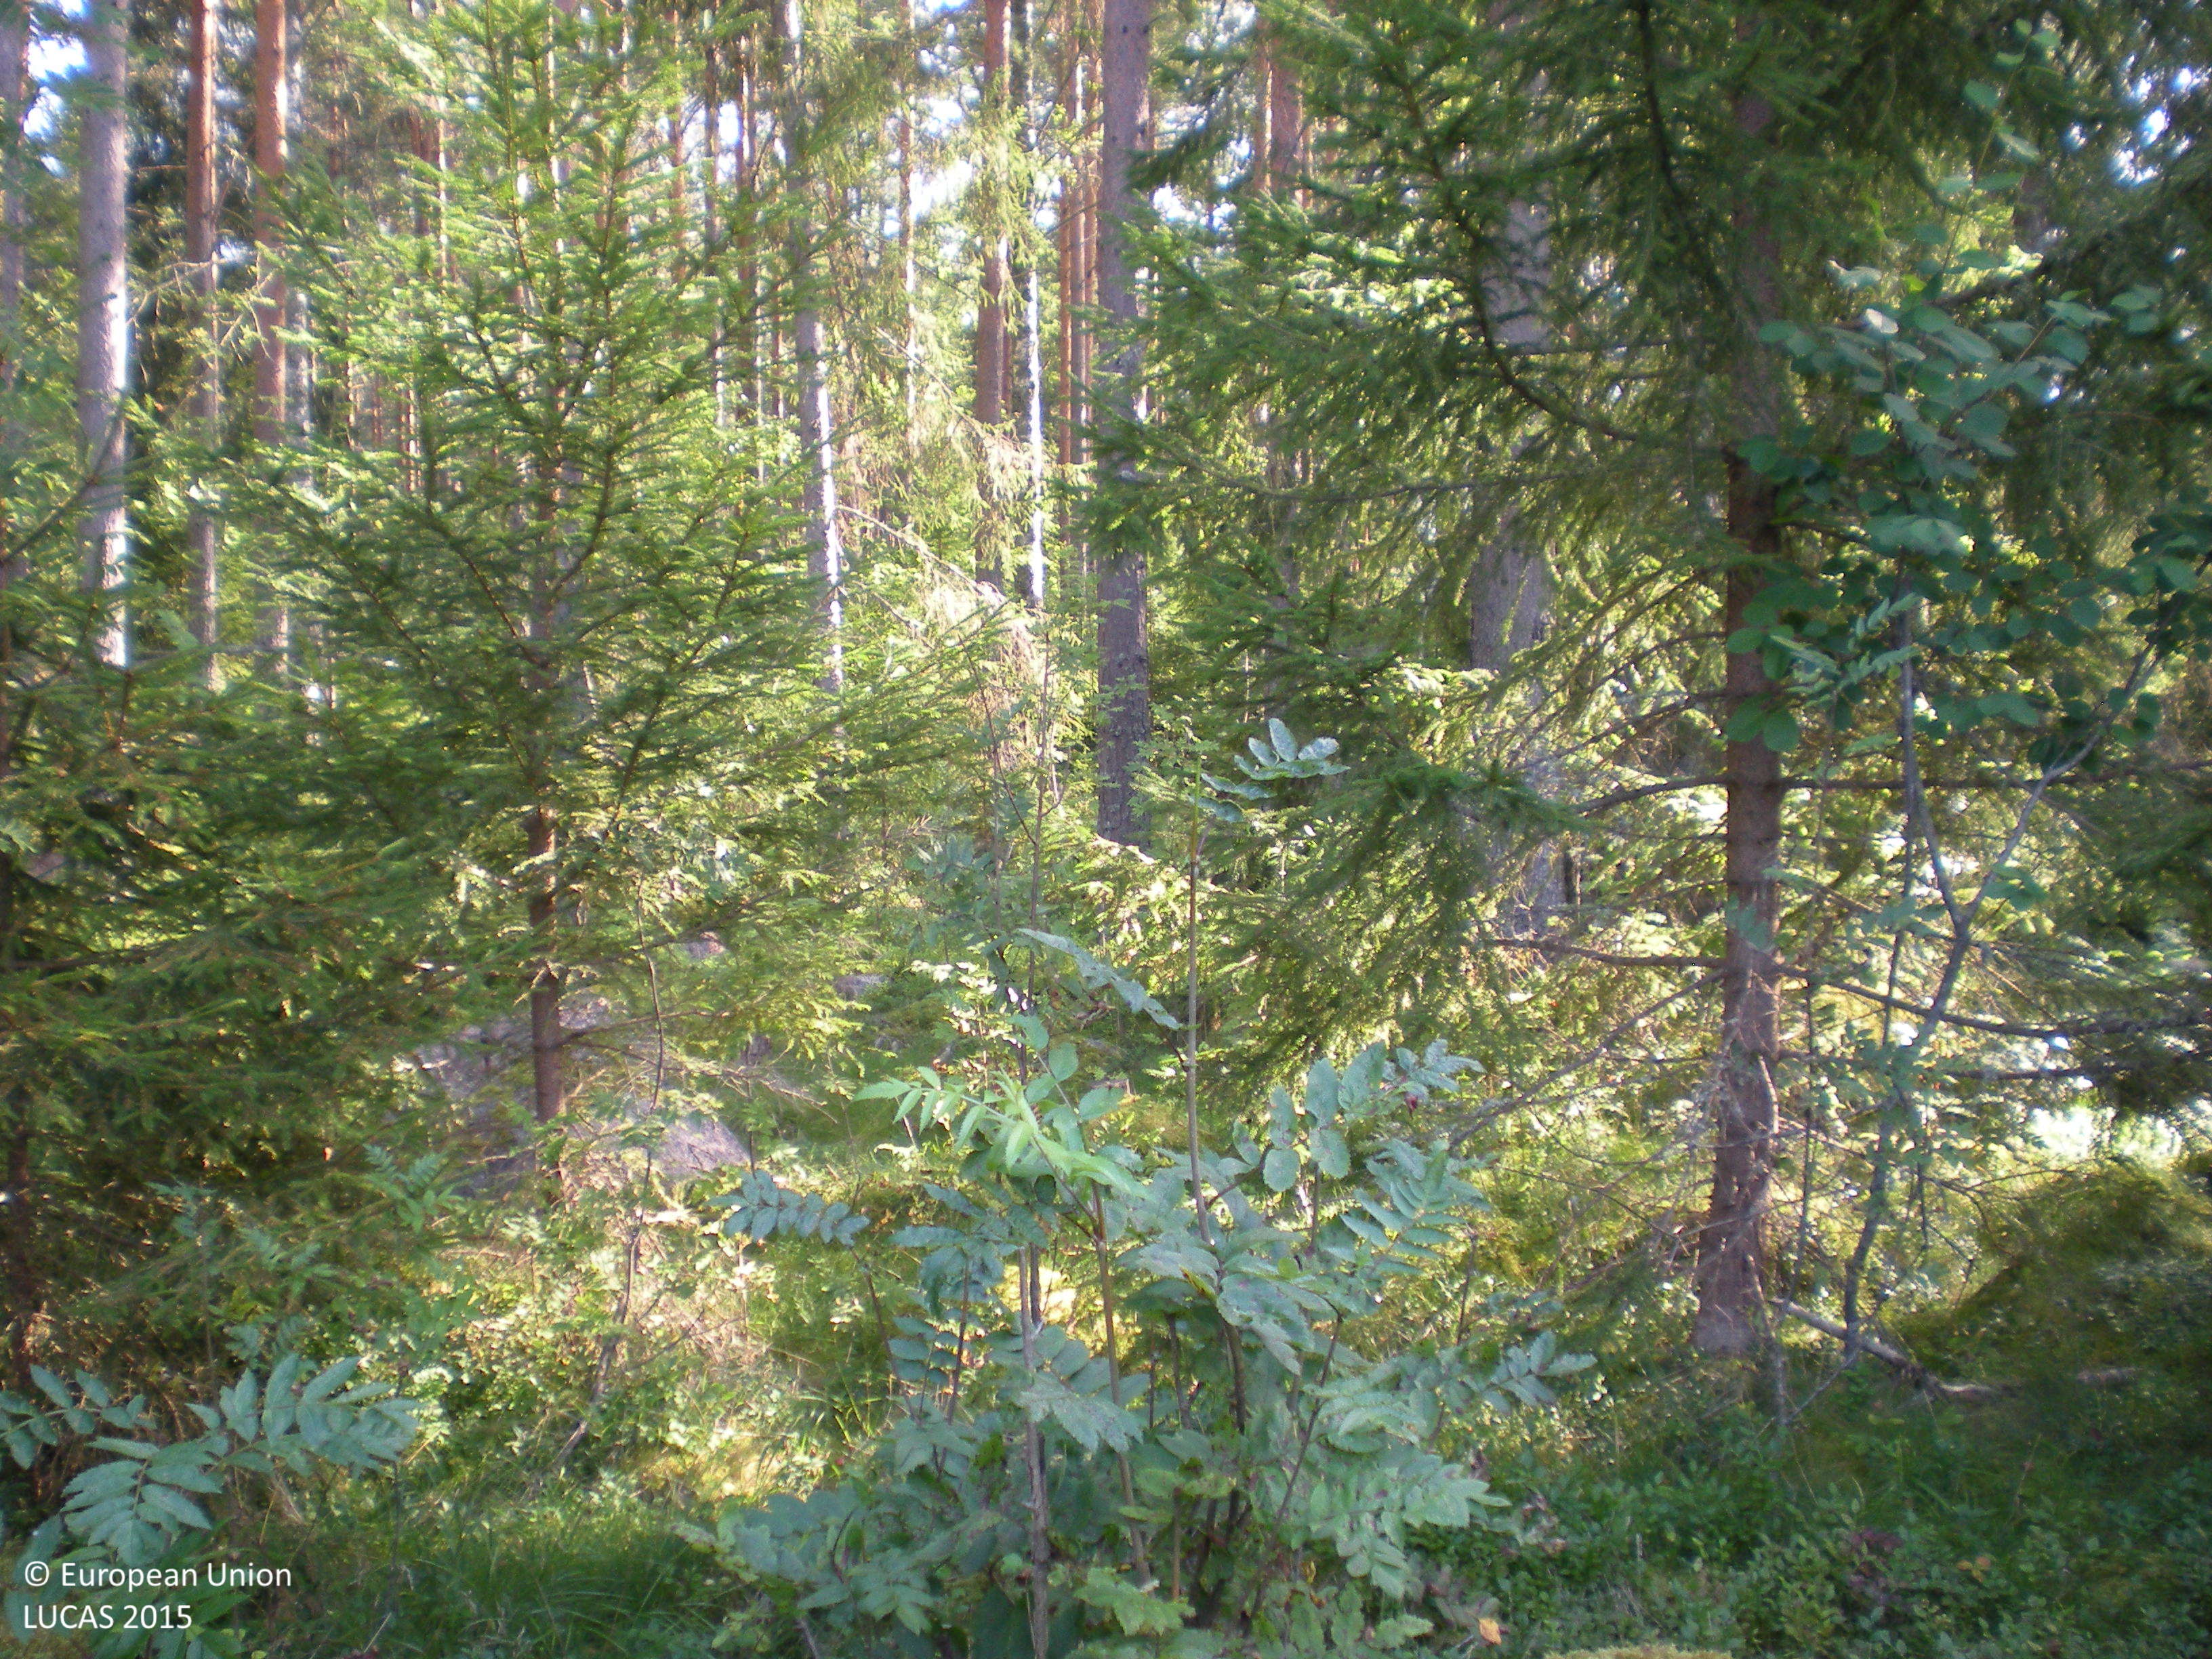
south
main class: Woodland
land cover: Spruce dominated coniferous woodland
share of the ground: 50 - 75 %
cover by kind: coniferous forest trees 50 %, shrubs 20 %, broadleaved forest trees 10 %, lichens and mosses 10 %, herbaceous plants 5 %, consolidated bare surface 5 %
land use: Forestry
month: August
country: SE
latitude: 60.3842
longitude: 17.0469
